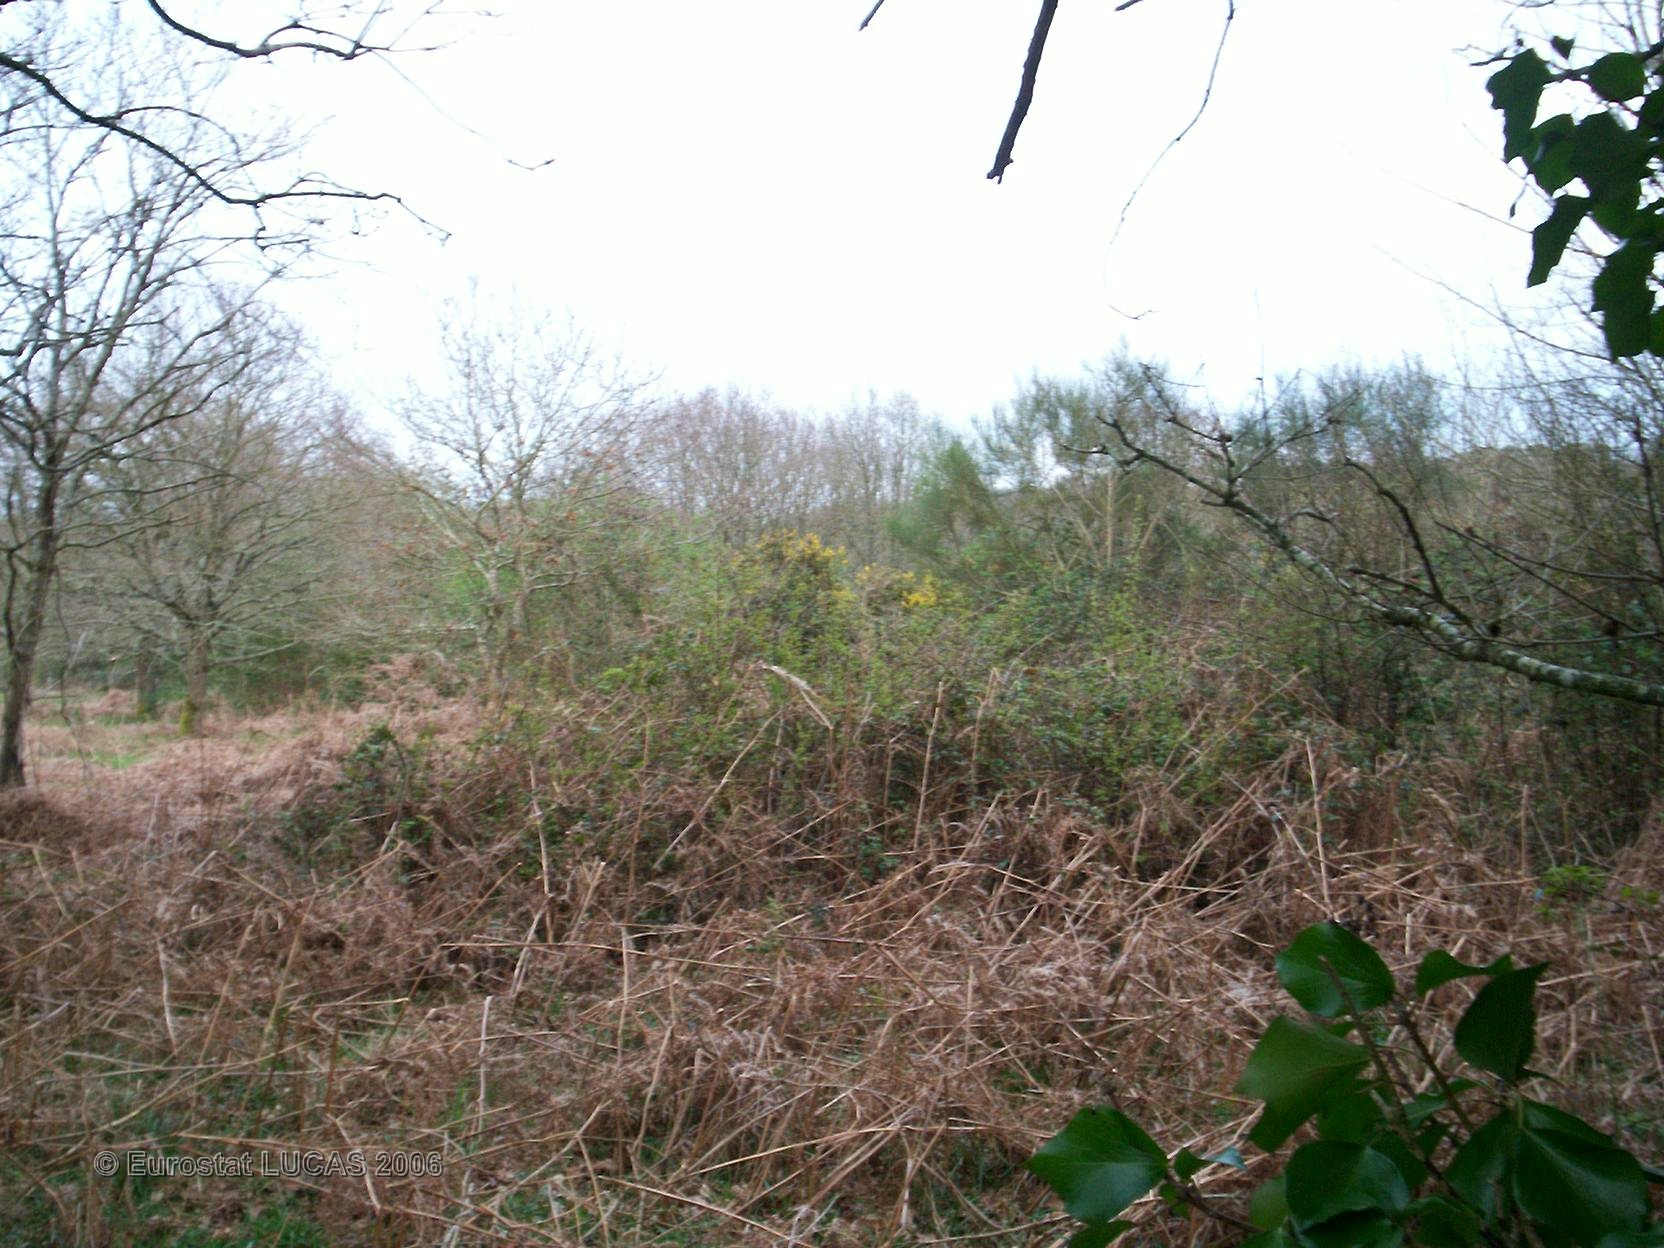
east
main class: Woodland
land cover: Broadleaved forest
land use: Forestry
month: April
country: FR
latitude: 47.7942
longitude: -3.4646
